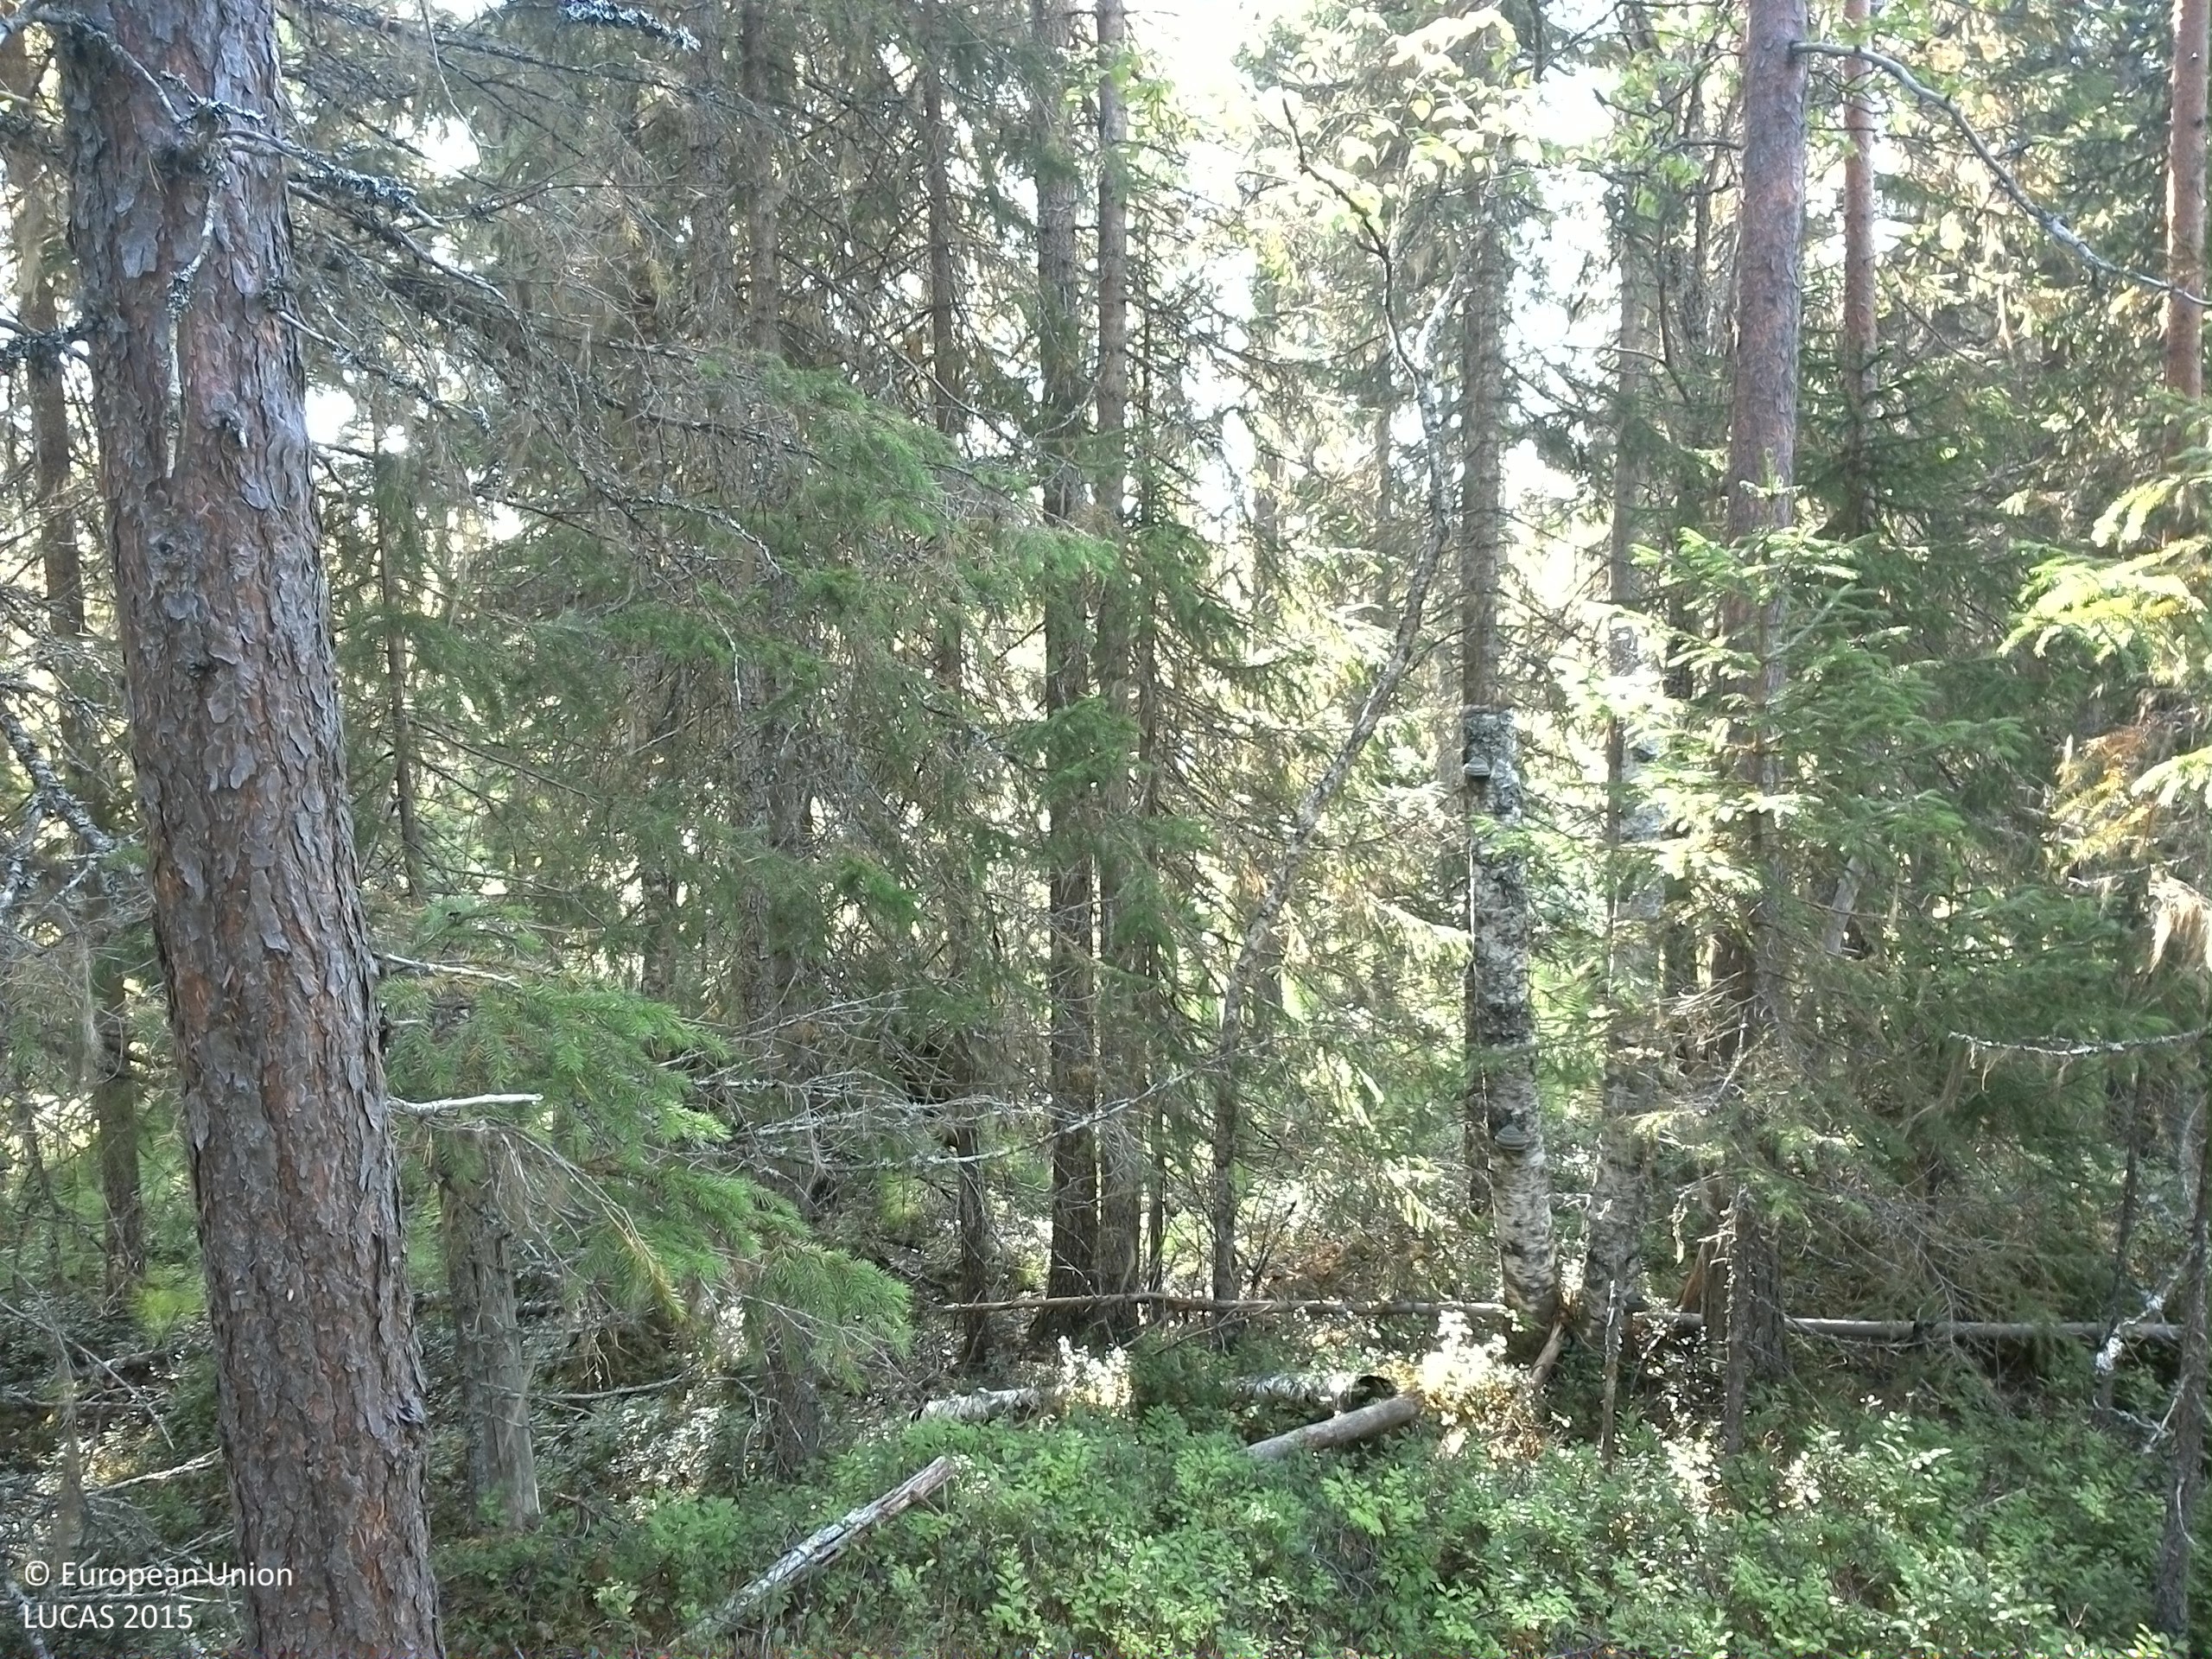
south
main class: Woodland
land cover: Spruce dominated coniferous woodland
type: boreal forest
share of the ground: 50 - 75 %
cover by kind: coniferous forest trees 60 %, shrubs 20 %, lichens and mosses 15 %, broadleaved forest trees 5 %
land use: Forestry
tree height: > 5 m
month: September
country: SE
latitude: 64.0490
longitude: 16.4633
